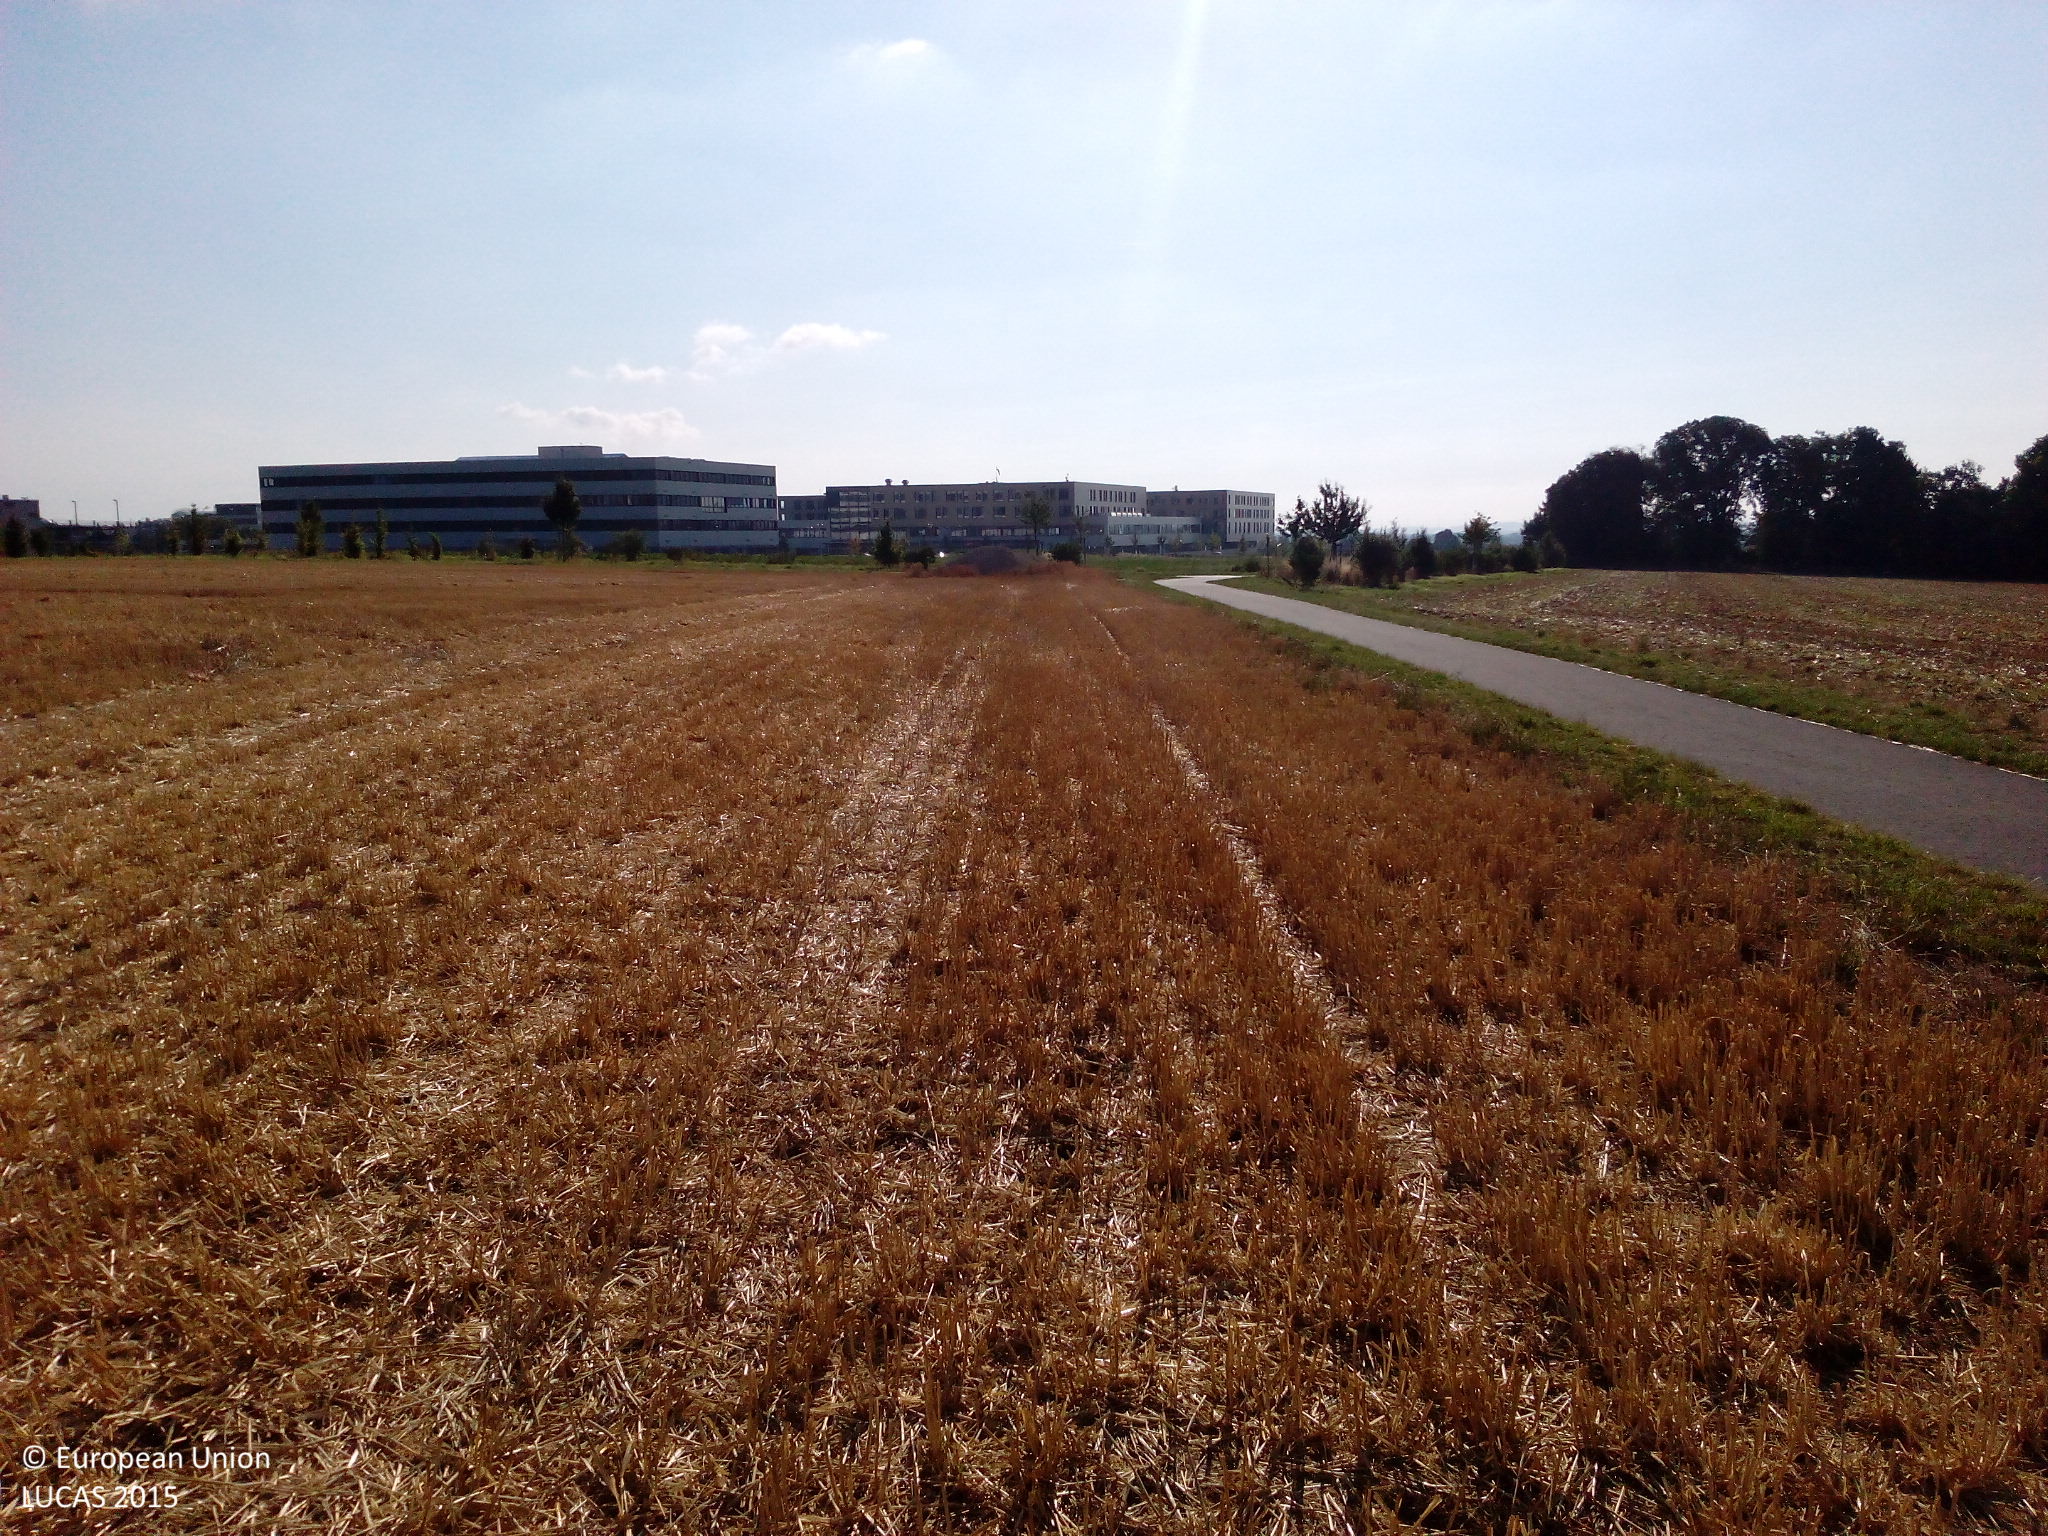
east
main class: Cropland
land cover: Common wheat
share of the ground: 50 - 75 %
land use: Agriculture (excluding fallow land and kitchen gardens)
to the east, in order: Common wheat; Grassland with sparse tree/shrub cover; Paved roads, cycling and walking lanes; Grassland with sparse tree/shrub cover; Potatoes
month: July
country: DE
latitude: 50.2118
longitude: 8.6131
